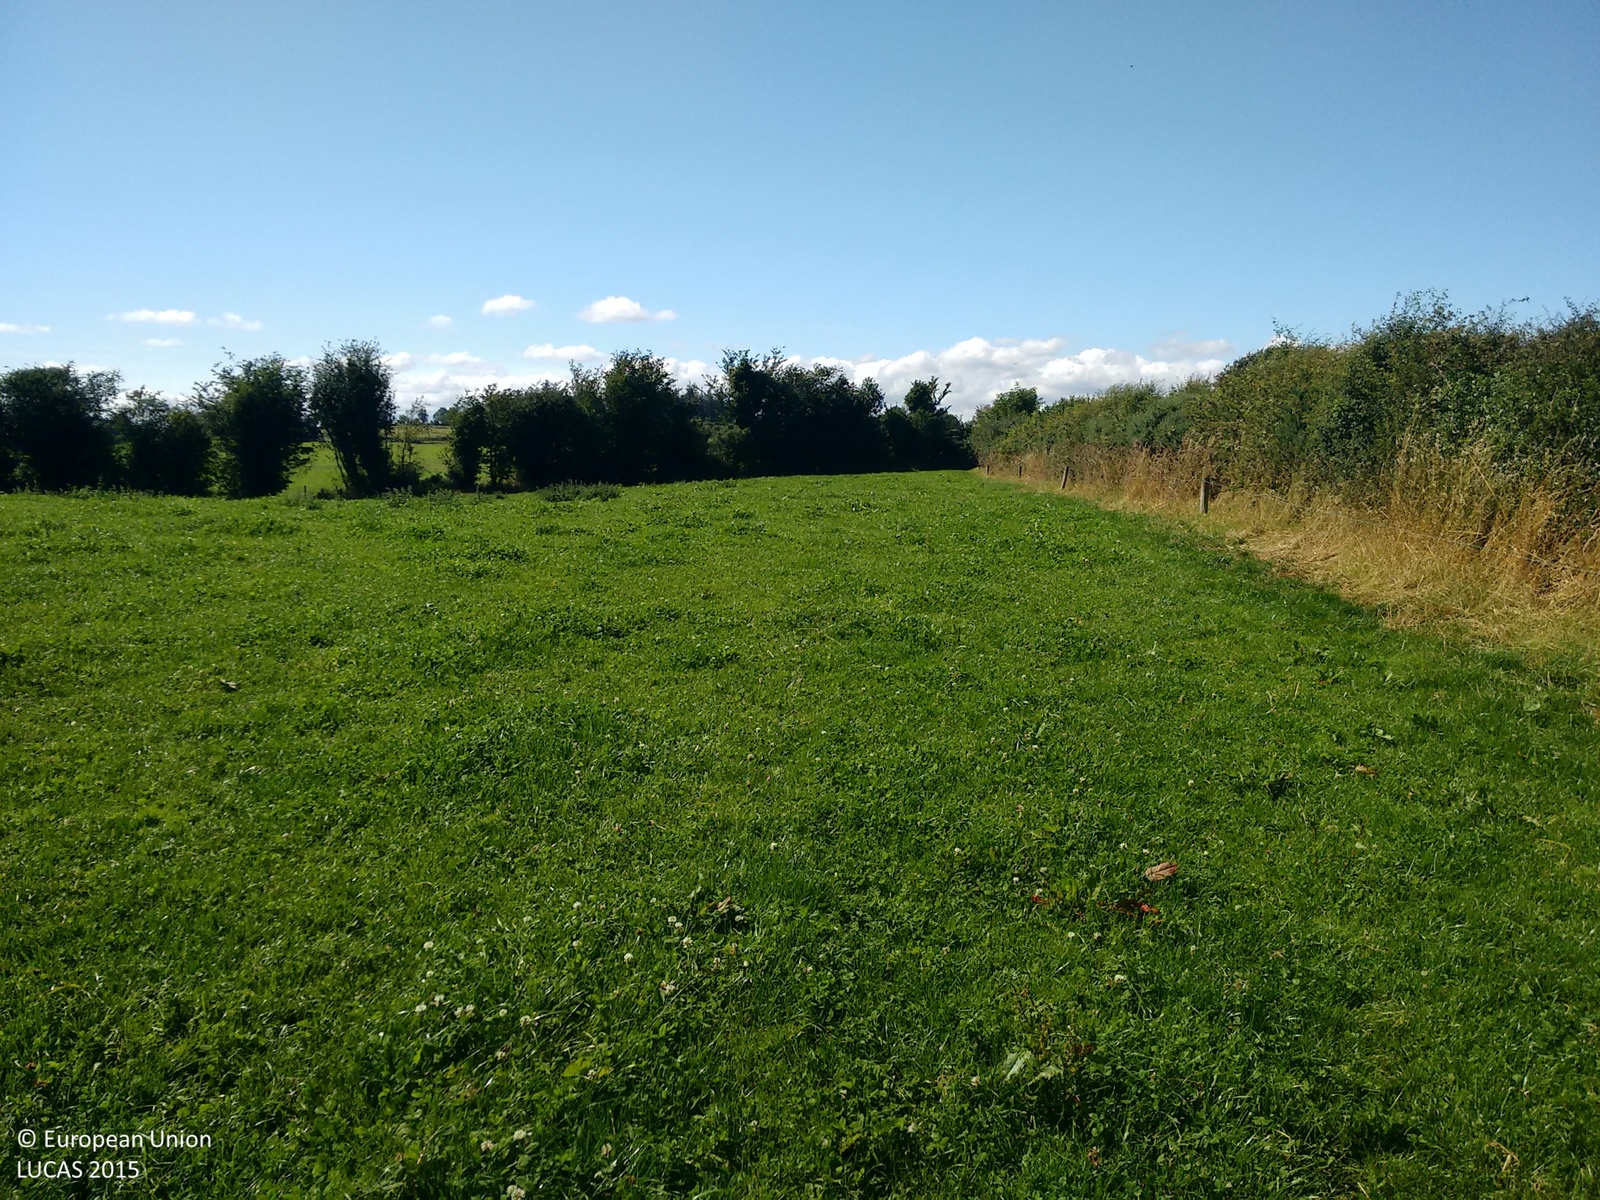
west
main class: Grassland
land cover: Grassland without tree/shrub cover
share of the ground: > 75 %
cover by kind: herbaceous plants 100 %
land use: Agriculture (excluding fallow land and kitchen gardens)
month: August
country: IE
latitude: 52.9124
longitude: -7.6976
